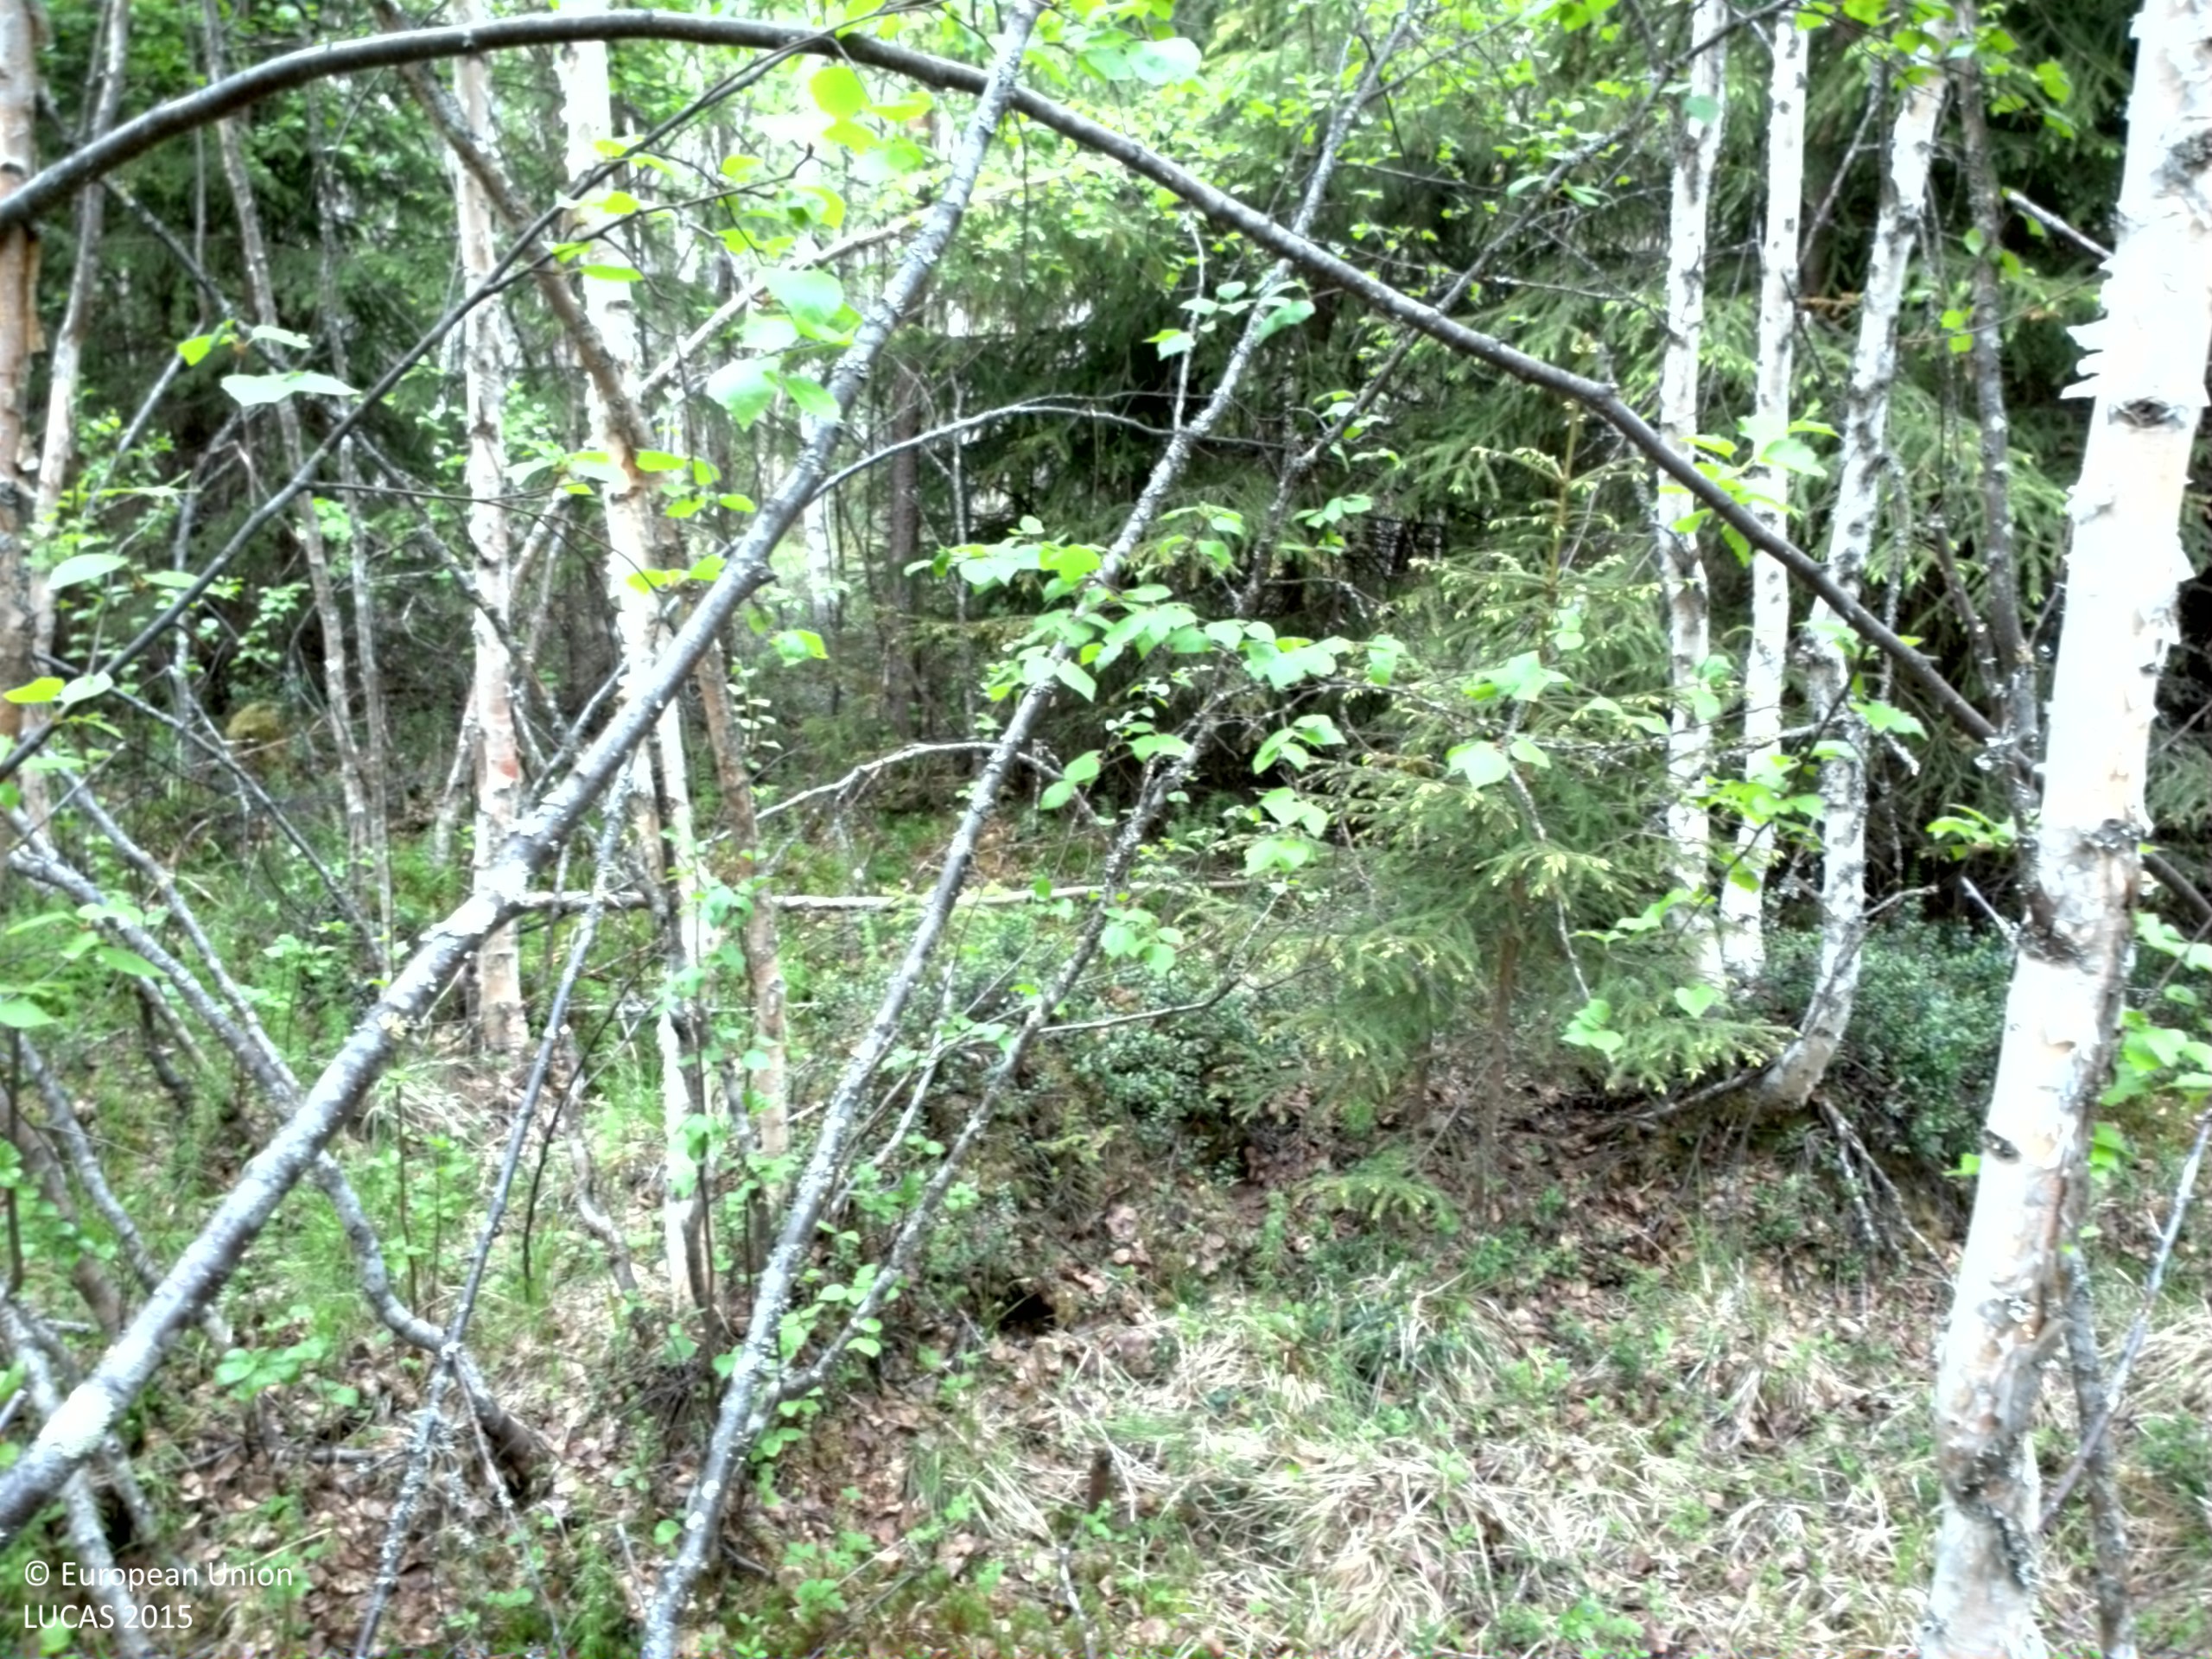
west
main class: Woodland
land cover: Broadleaved woodland
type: boreal forest
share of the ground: > 75 %
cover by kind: broadleaved forest trees 80 %, coniferous forest trees 10 %, herbaceous plants 10 %
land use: Forestry
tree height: > 5 m
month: June
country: SE
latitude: 63.1403
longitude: 17.3363
